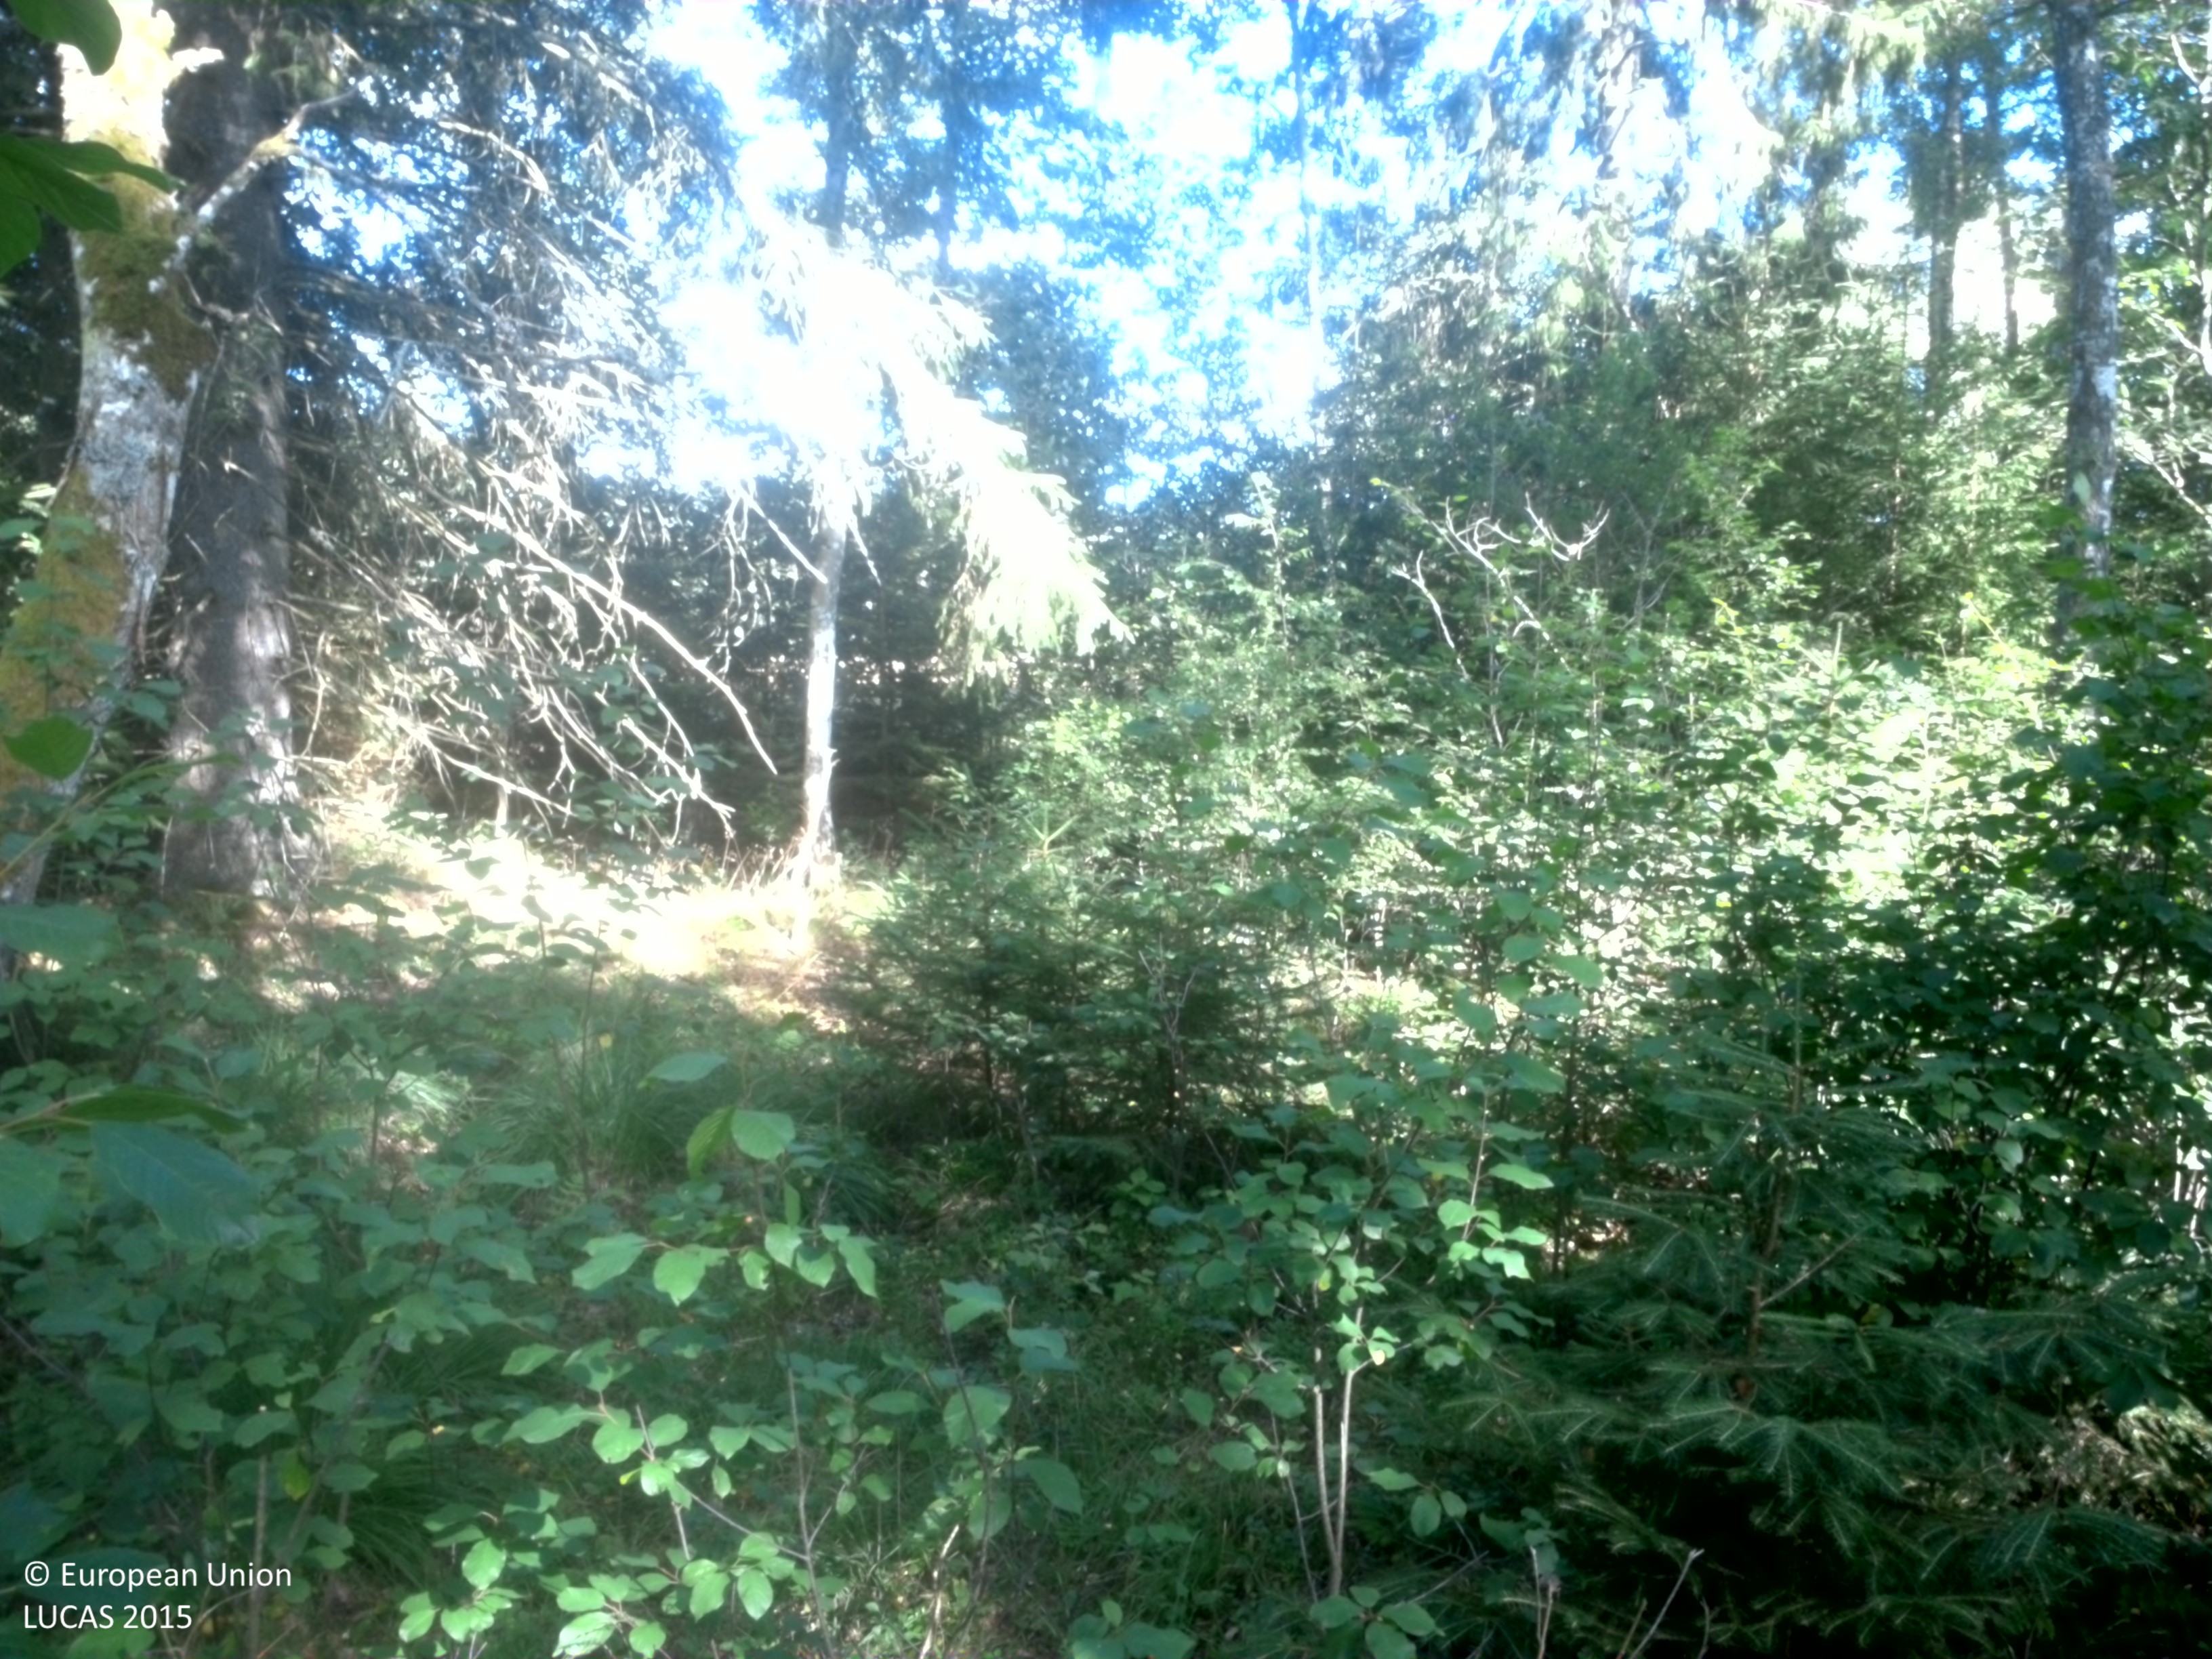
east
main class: Woodland
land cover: Broadleaved woodland
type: boreal forest
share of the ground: 50 - 75 %
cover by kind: broadleaved forest trees 55 %, herbaceous plants 35 %, coniferous forest trees 5 %, shrubs 5 %
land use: Forestry
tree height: > 5 m
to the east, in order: Broadleaved woodland; Spruce dominated mixed woodland; Ditches and canals; Spruce dominated mixed woodland; Temporary grasslands; Pine dominated coniferous woodland; Dry stone walls; Spruce dominated coniferous woodland
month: August
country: SE
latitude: 58.2865
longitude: 13.3203
